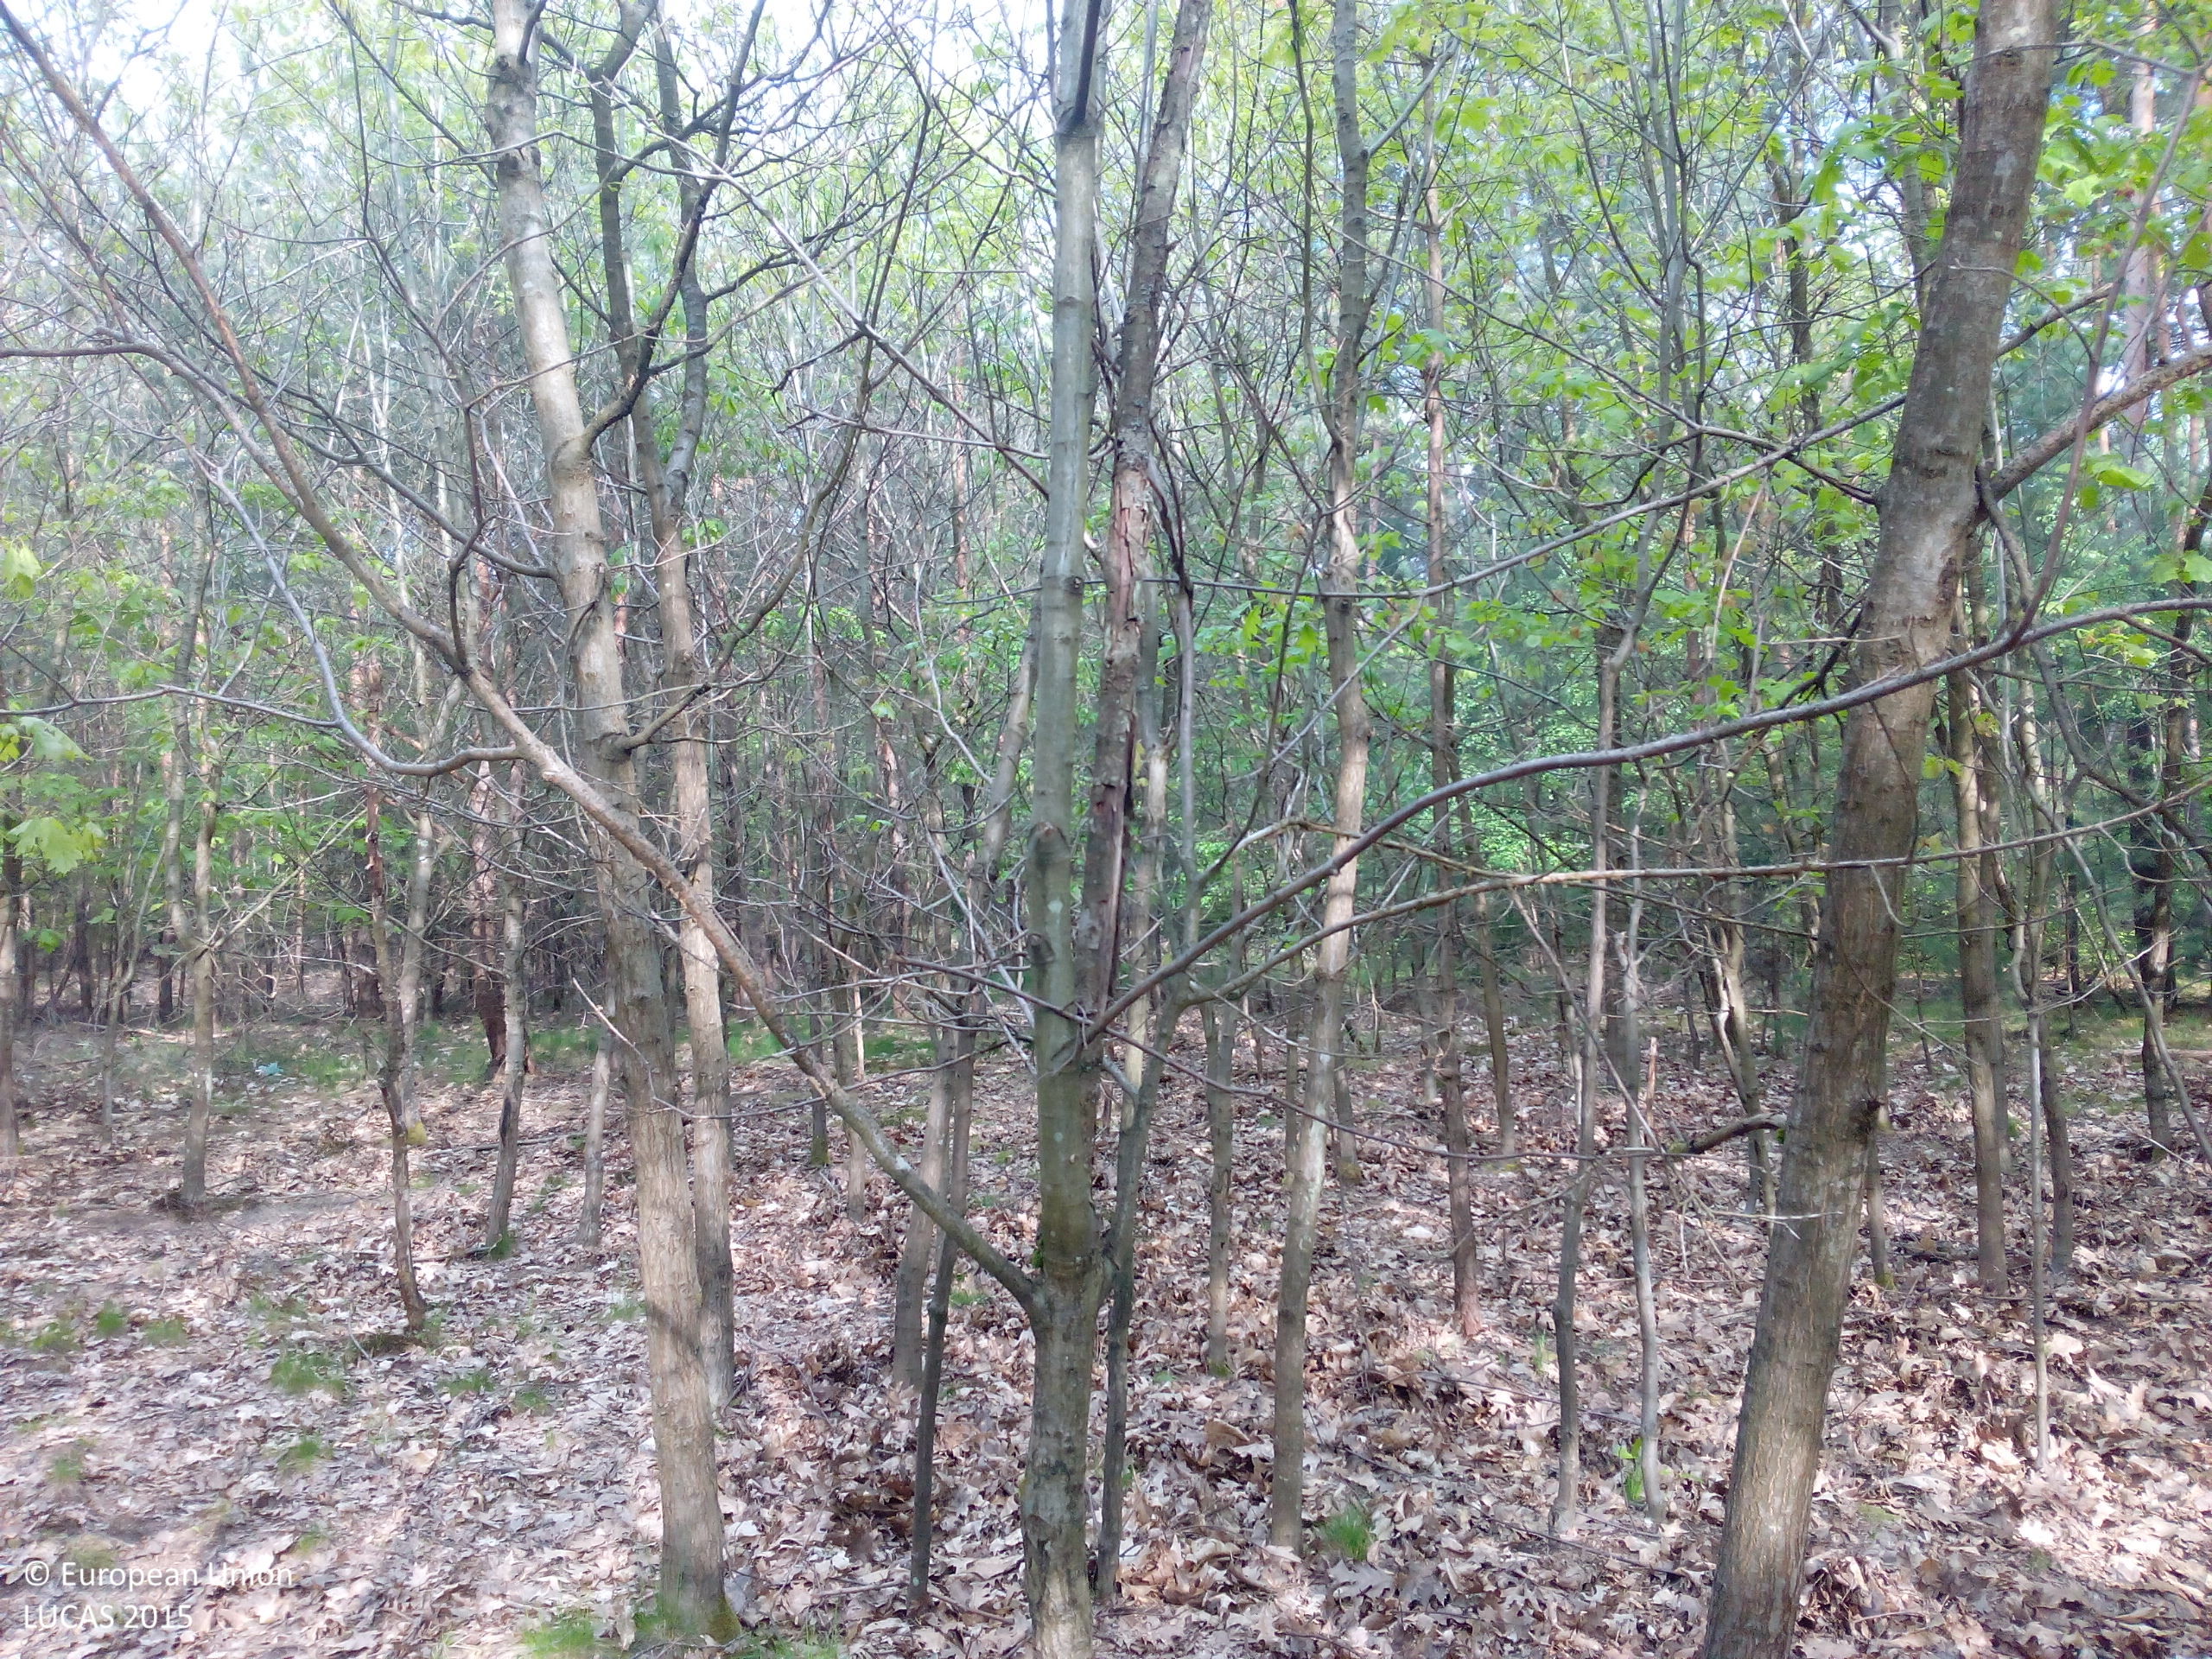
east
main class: Woodland
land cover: Broadleaved woodland
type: acidophilous oak and oak-birch forest
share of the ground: 50 - 75 %
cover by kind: broadleaved forest trees 70 %, unconsolidated bare surface 20 %, herbaceous plants 5 %, lichens and mosses 5 %
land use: Forestry
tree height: > 5 m
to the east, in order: Broadleaved woodland; Pine dominated coniferous woodland; Tracks; Broadleaved woodland; Tracks; Pine dominated mixed woodland
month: May
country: DE
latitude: 49.6354
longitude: 8.5466
